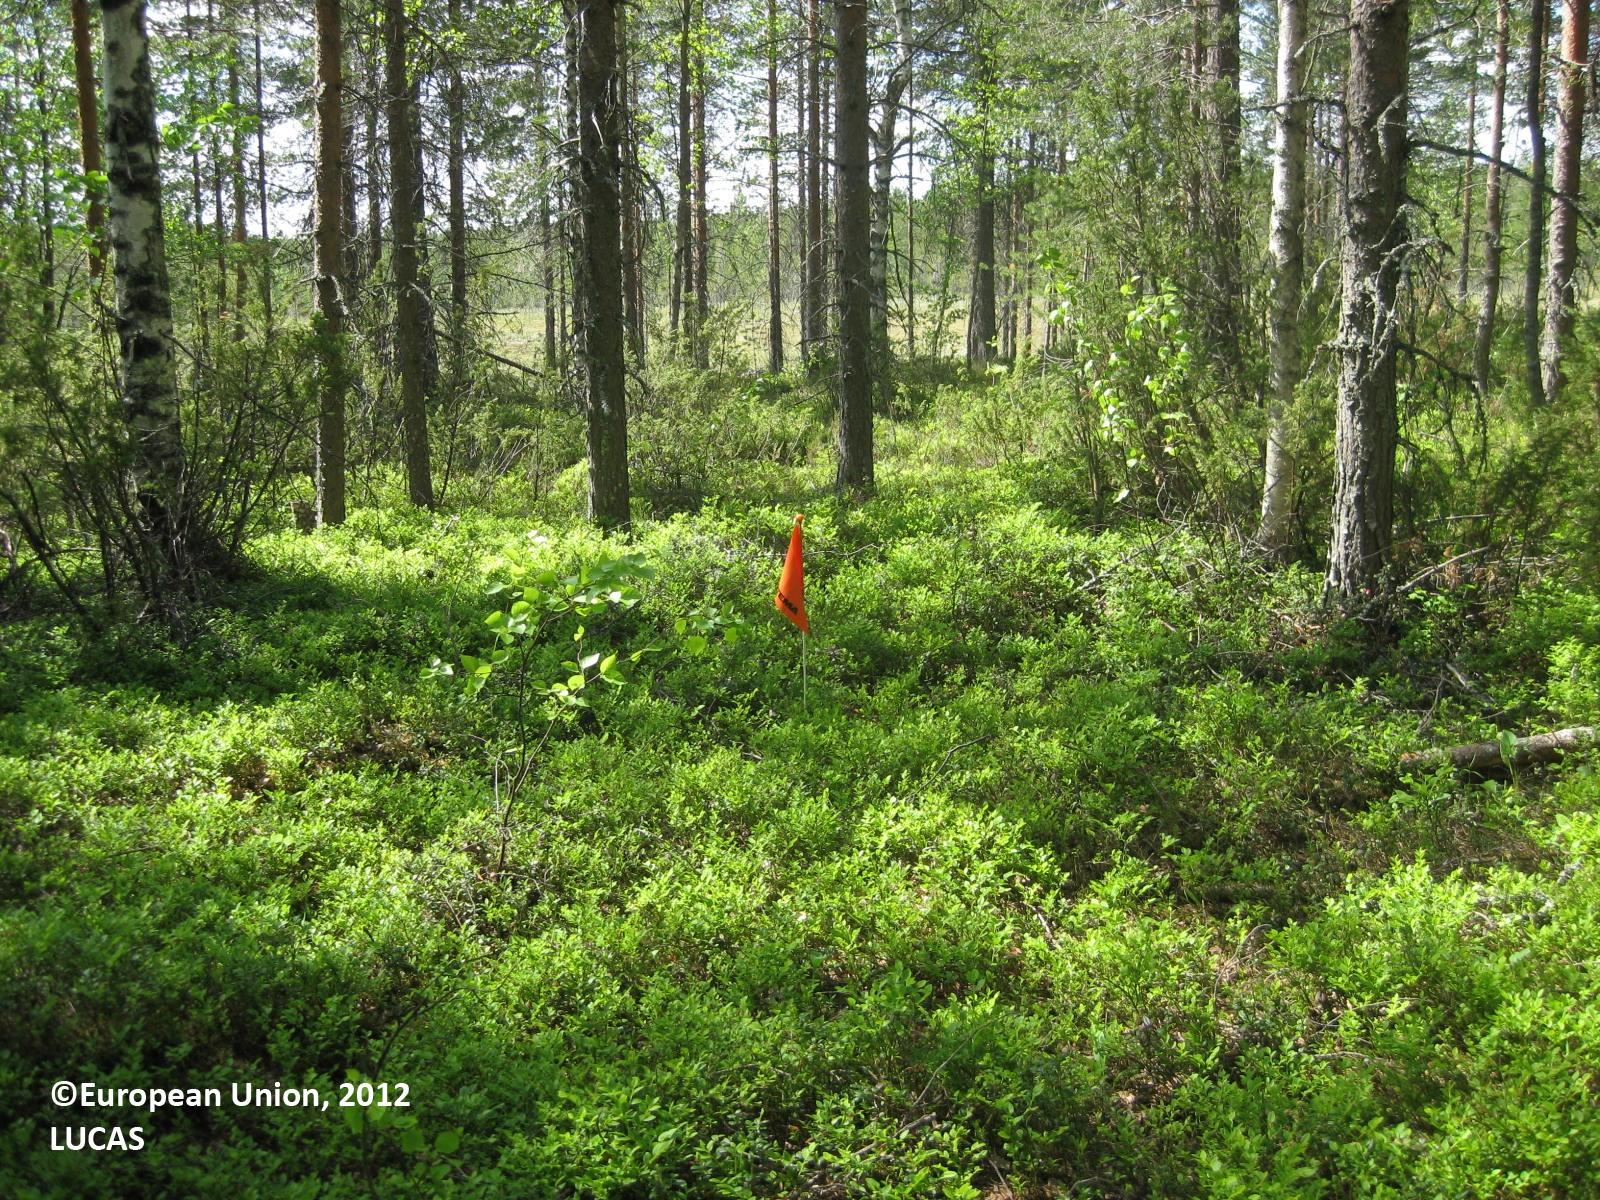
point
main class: Woodland
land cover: Pine dominated mixed woodland
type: boreal forest
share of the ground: > 75 %
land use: Forestry
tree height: > 5 m
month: June
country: FI
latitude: 65.0146
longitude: 28.9635
